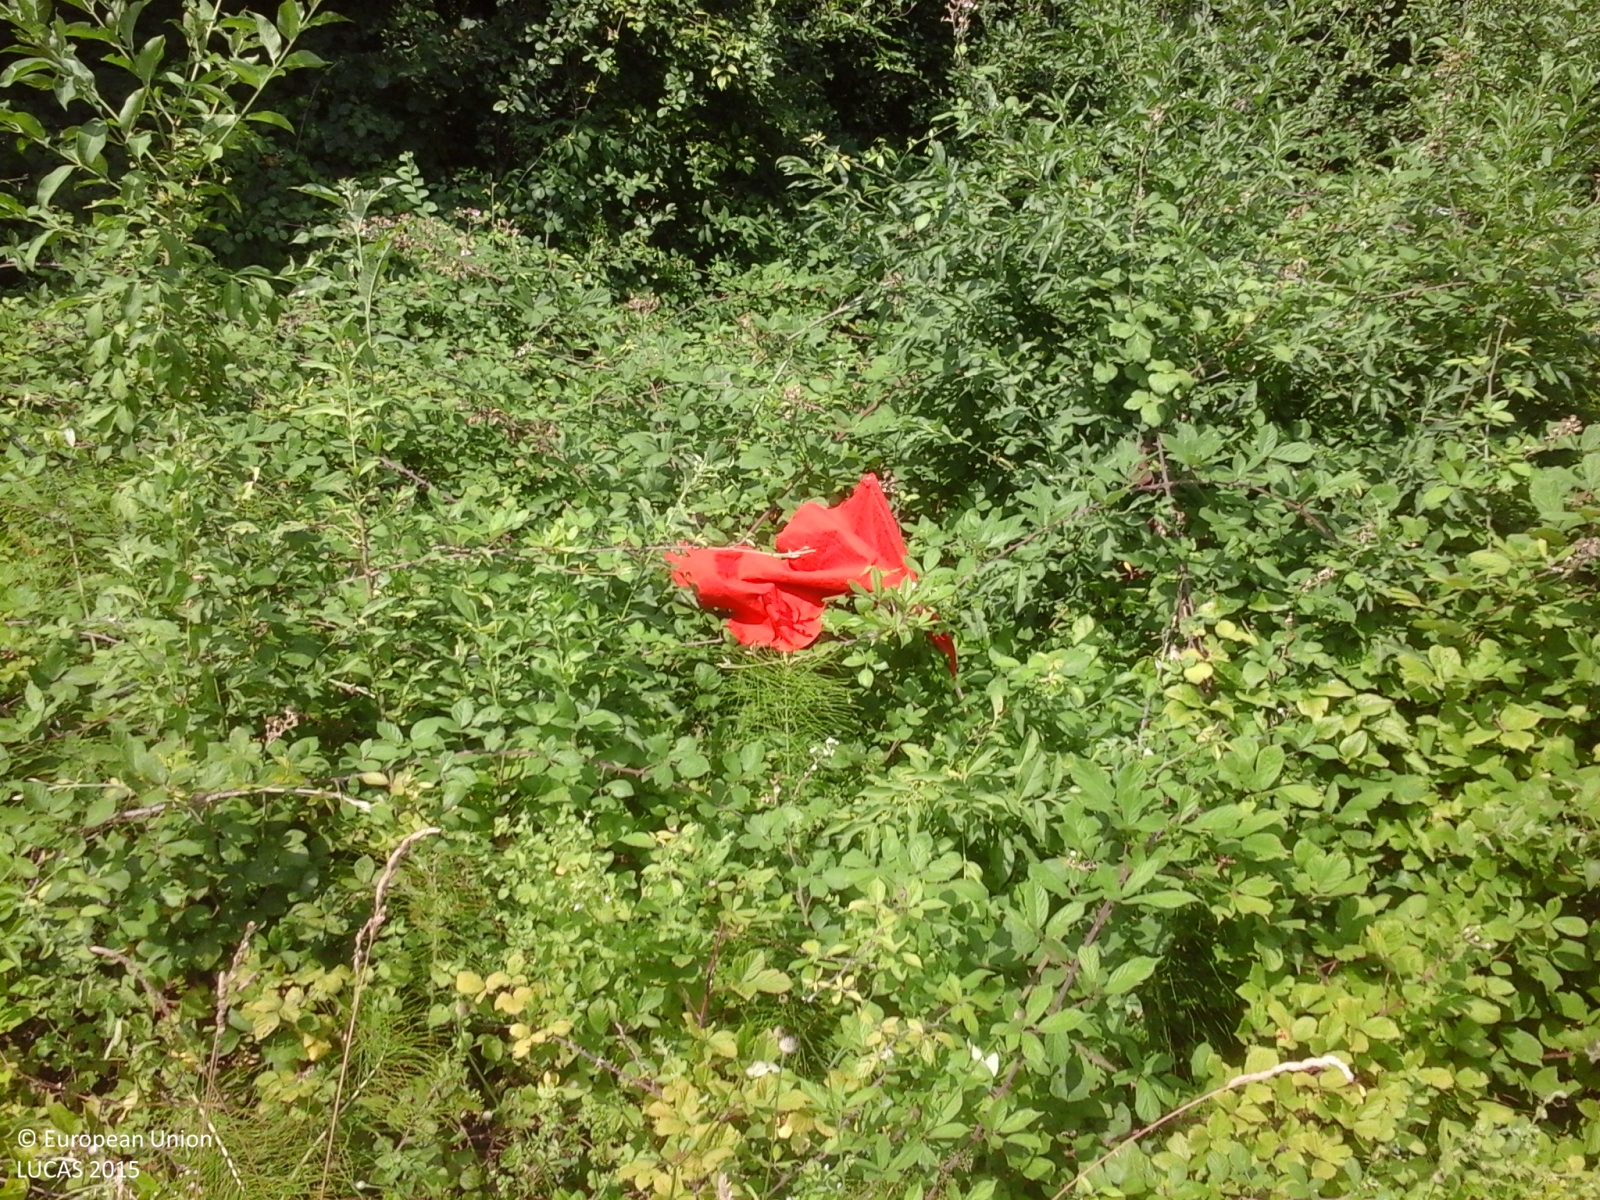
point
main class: Shrubland
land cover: Shrubland without tree cover
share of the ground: > 75 %
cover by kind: shrubs 95 %, herbaceous plants 5 %
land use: Semi-natural and natural areas not in use
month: July
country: IT
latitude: 43.0515
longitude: 13.3179
